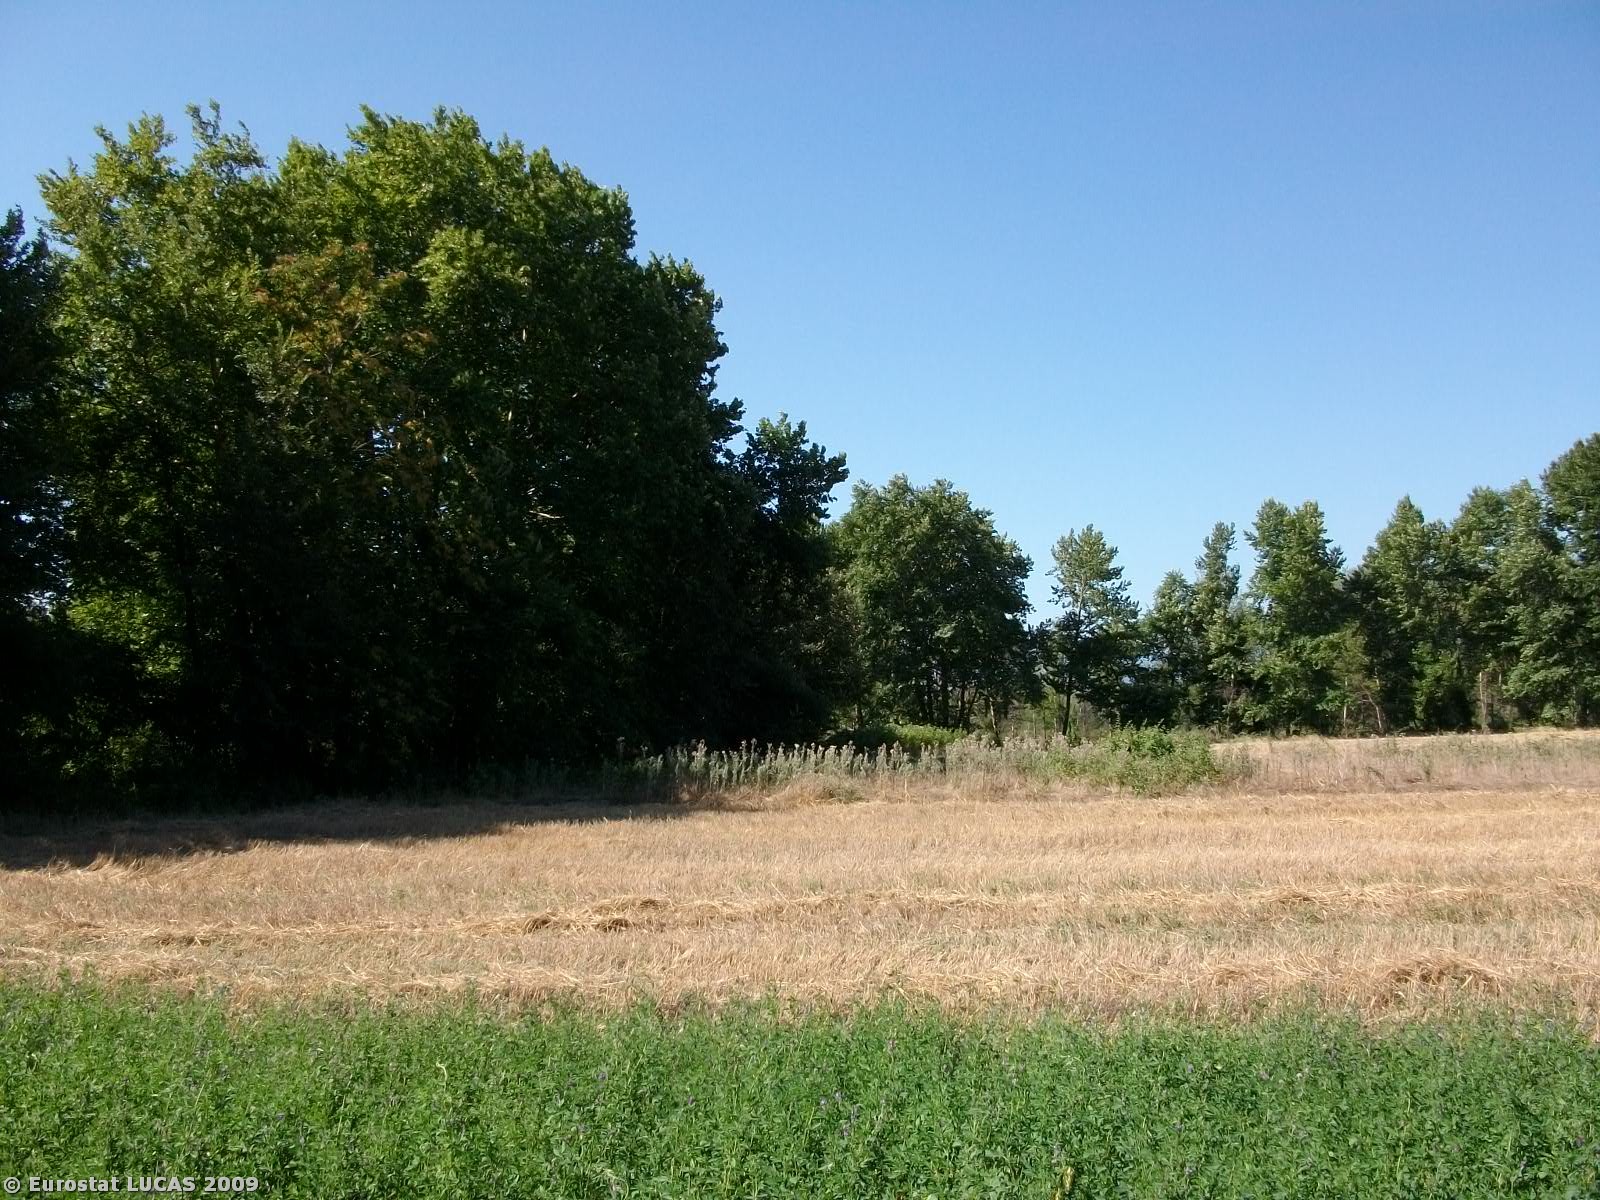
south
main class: Cropland
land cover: Clovers
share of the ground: > 75 %
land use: Agriculture (excluding fallow land and kitchen gardens)
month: July
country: GR
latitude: 39.5670
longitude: 21.6811
